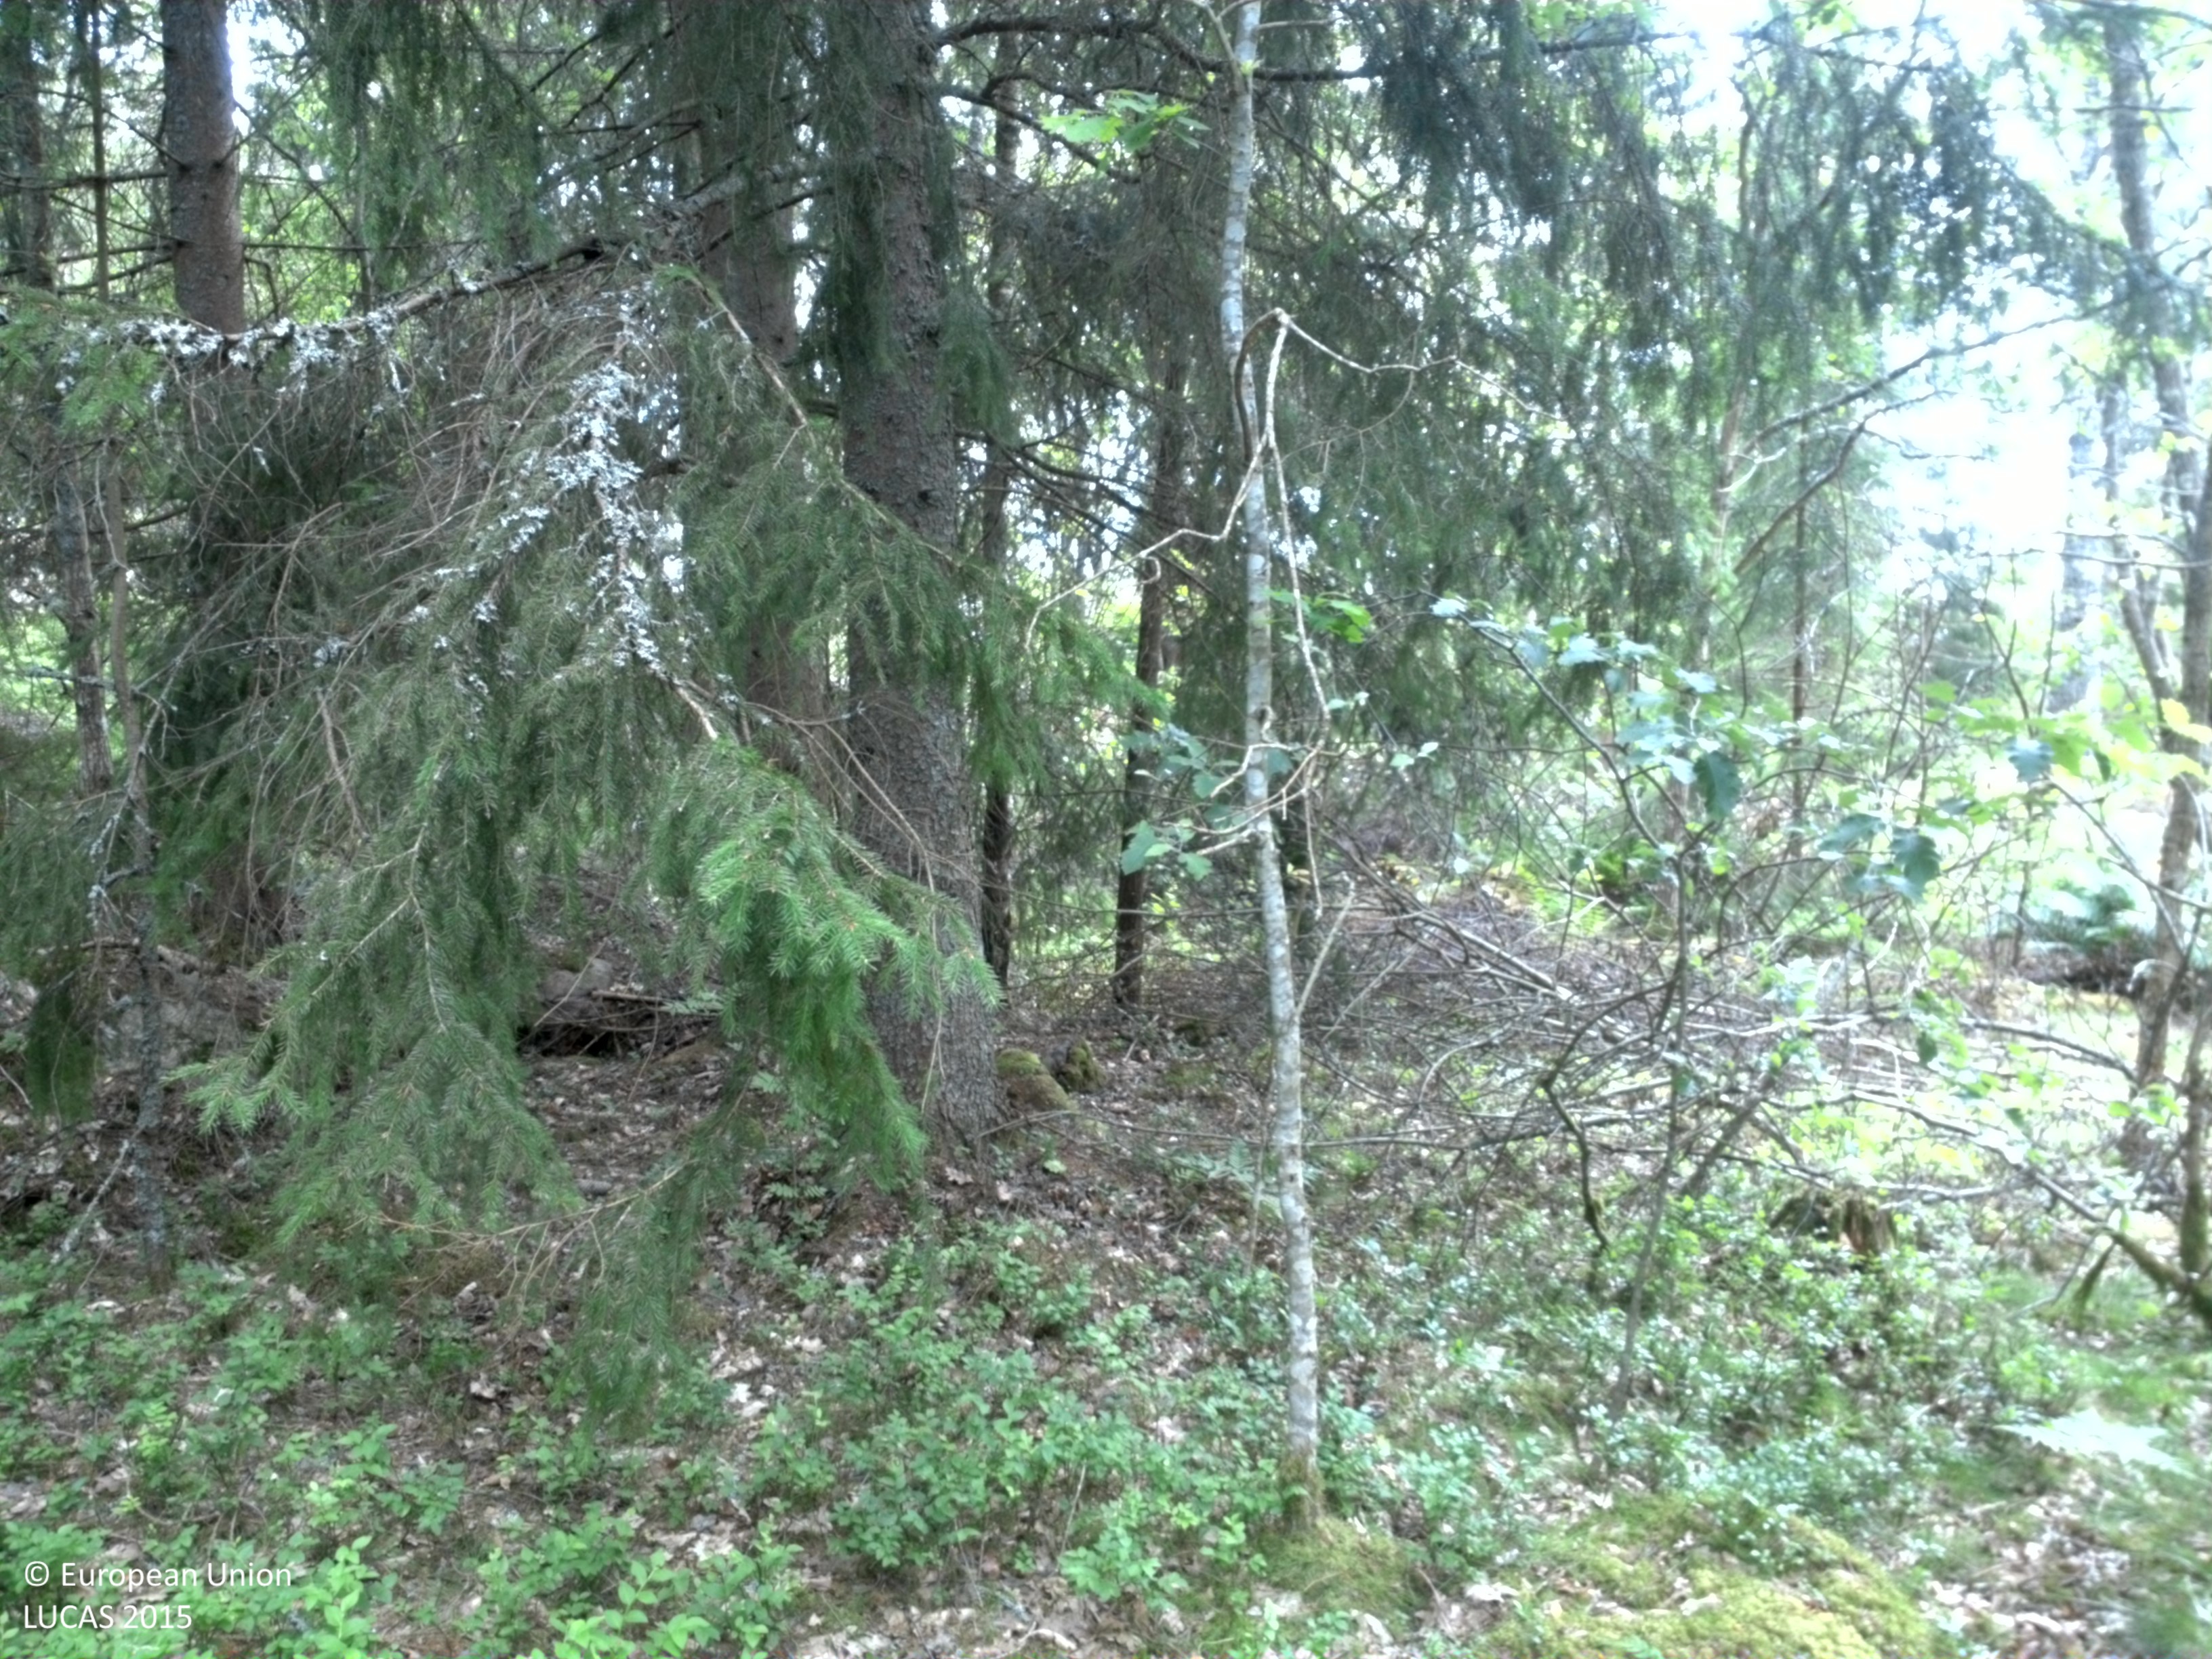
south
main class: Woodland
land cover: Spruce dominated mixed woodland
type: boreal forest
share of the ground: 50 - 75 %
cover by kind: coniferous forest trees 40 %, herbaceous plants 30 %, broadleaved forest trees 20 %, lichens and mosses 10 %
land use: Forestry
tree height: > 5 m
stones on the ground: < 10 %
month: June
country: SE
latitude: 58.7310
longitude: 15.6765
